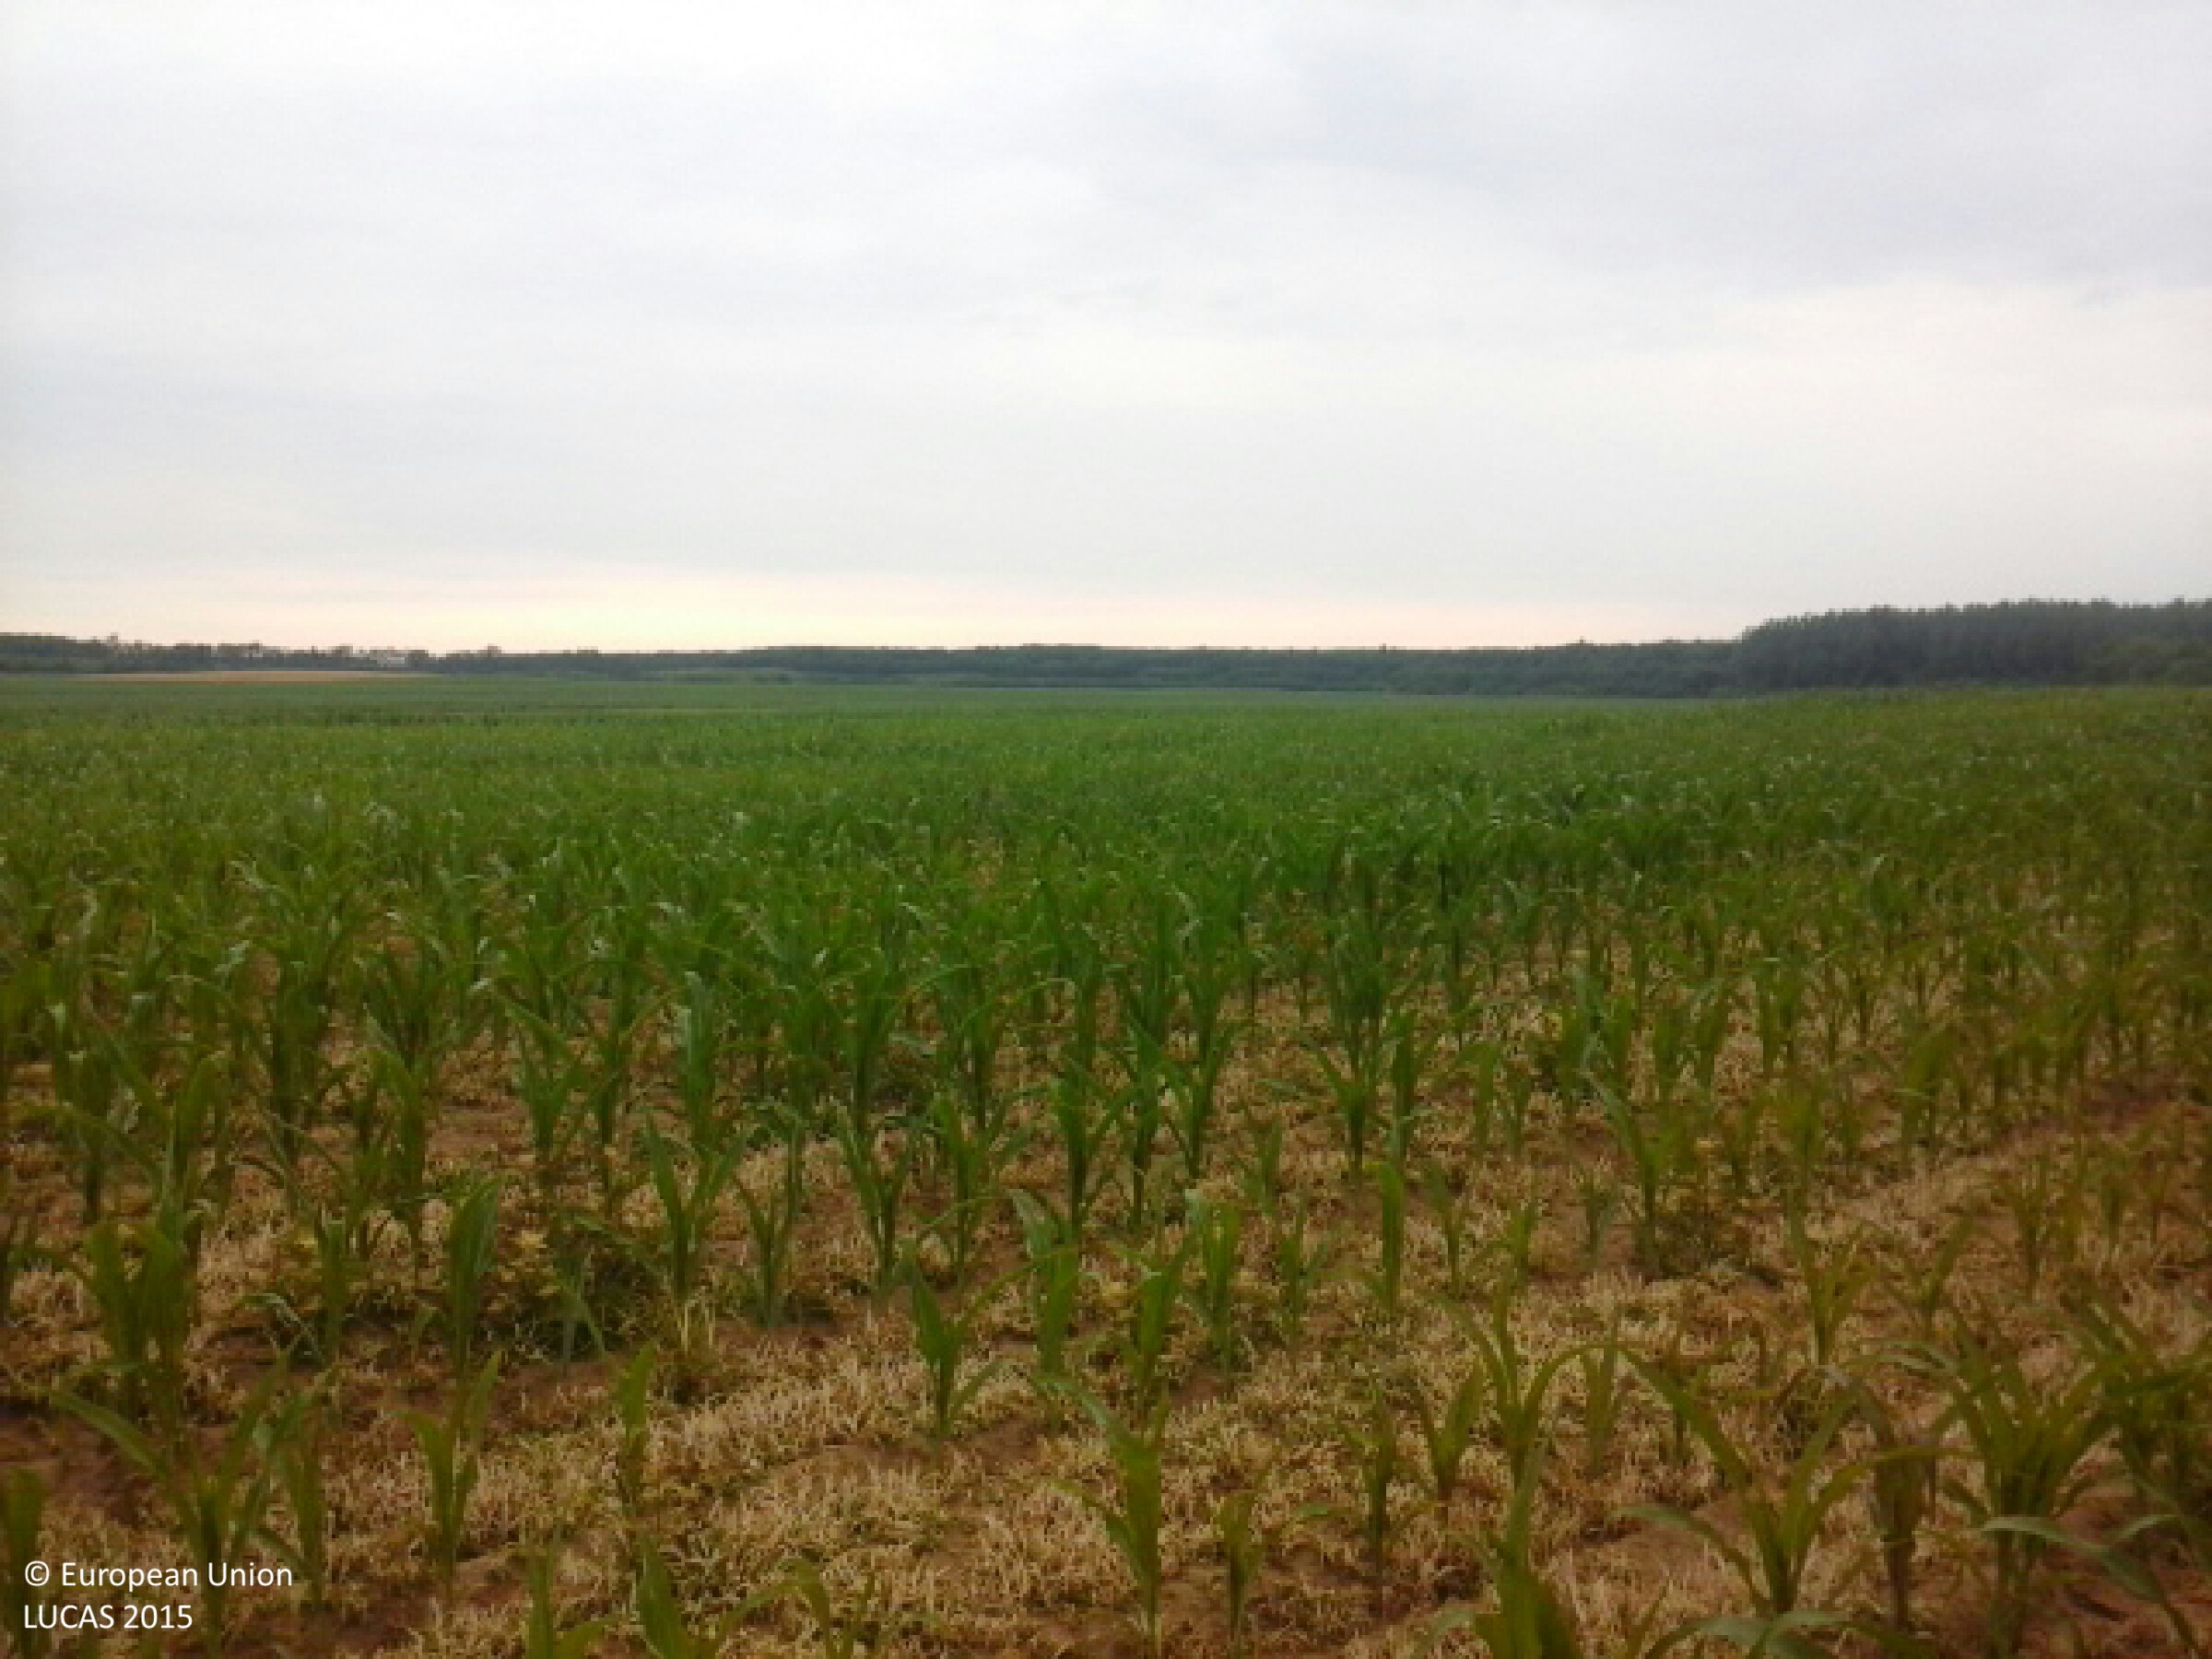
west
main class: Cropland
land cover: Maize
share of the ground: 25 - 50 %
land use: Agriculture (excluding fallow land and kitchen gardens)
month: June
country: HU
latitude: 47.9879
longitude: 22.1267
